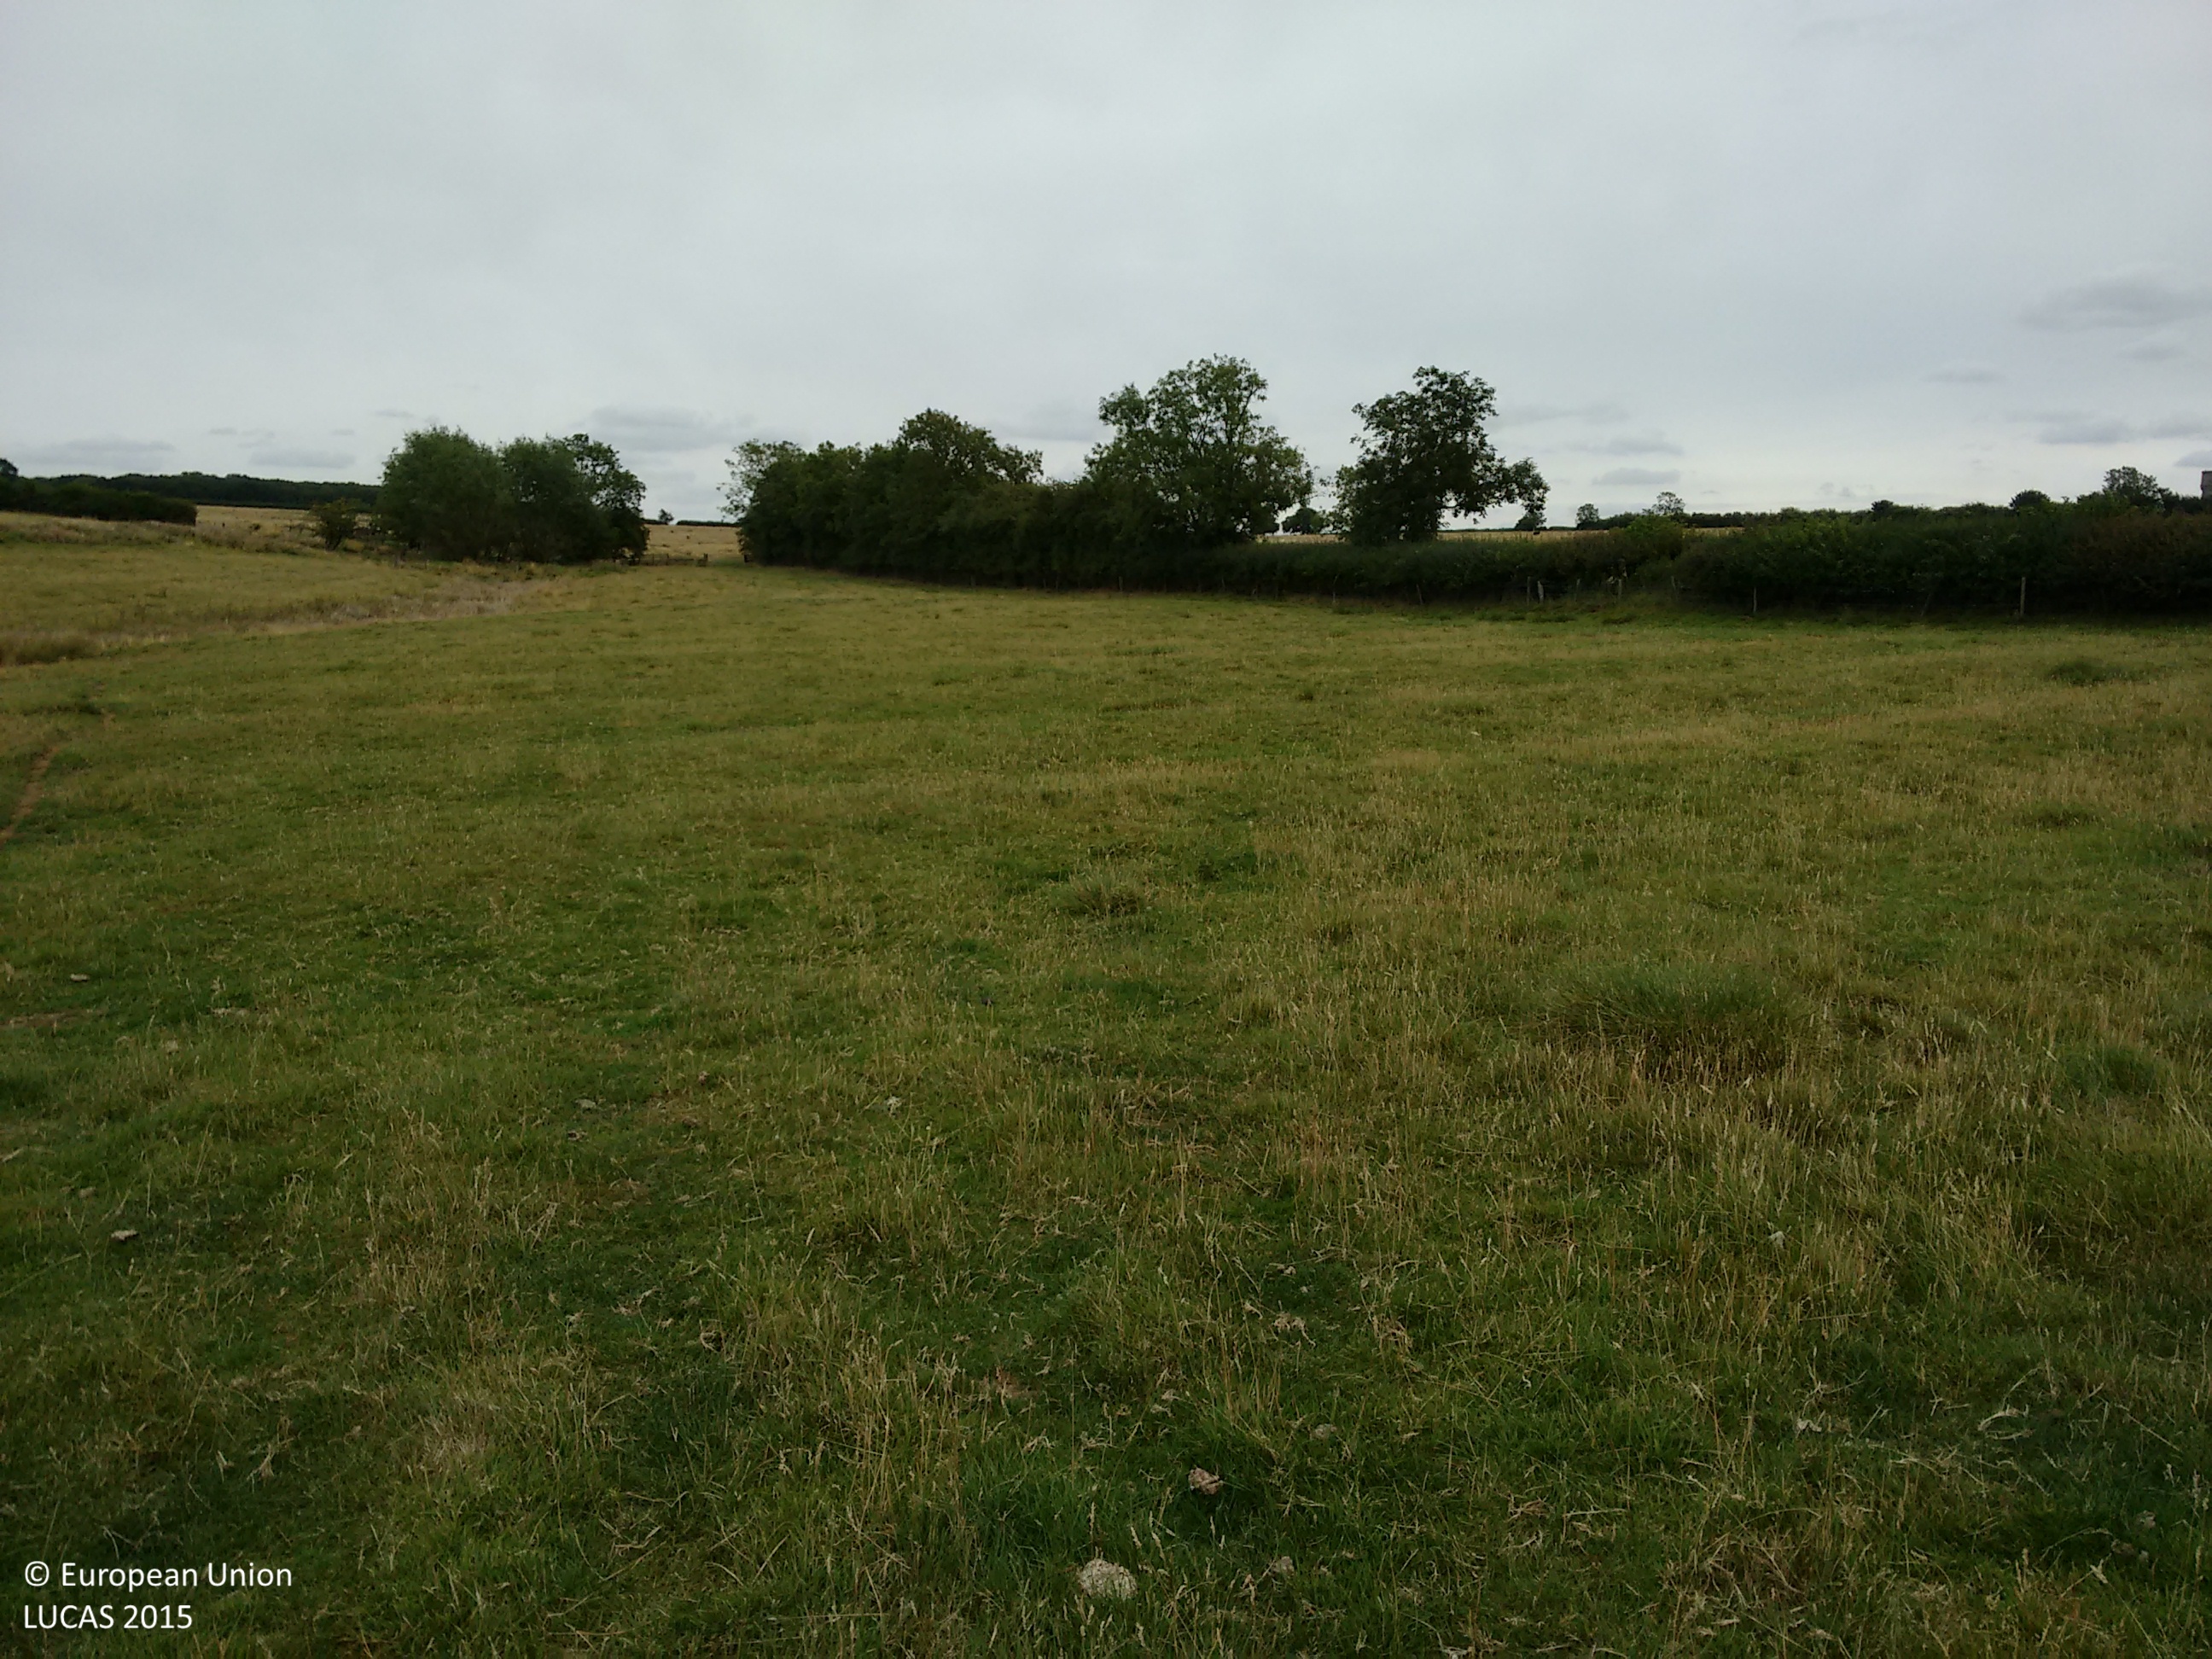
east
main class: Grassland
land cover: Grassland without tree/shrub cover
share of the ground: > 75 %
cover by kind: herbaceous plants 100 %
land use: Agriculture (excluding fallow land and kitchen gardens)
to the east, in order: Grassland without tree/shrub cover; Fences; Managed hedges; Grass margins; Rape and turnip rape; Managed hedges; Fences; Grassland without tree/shrub cover
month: August
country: GB
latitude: 52.0657
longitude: -1.1767
